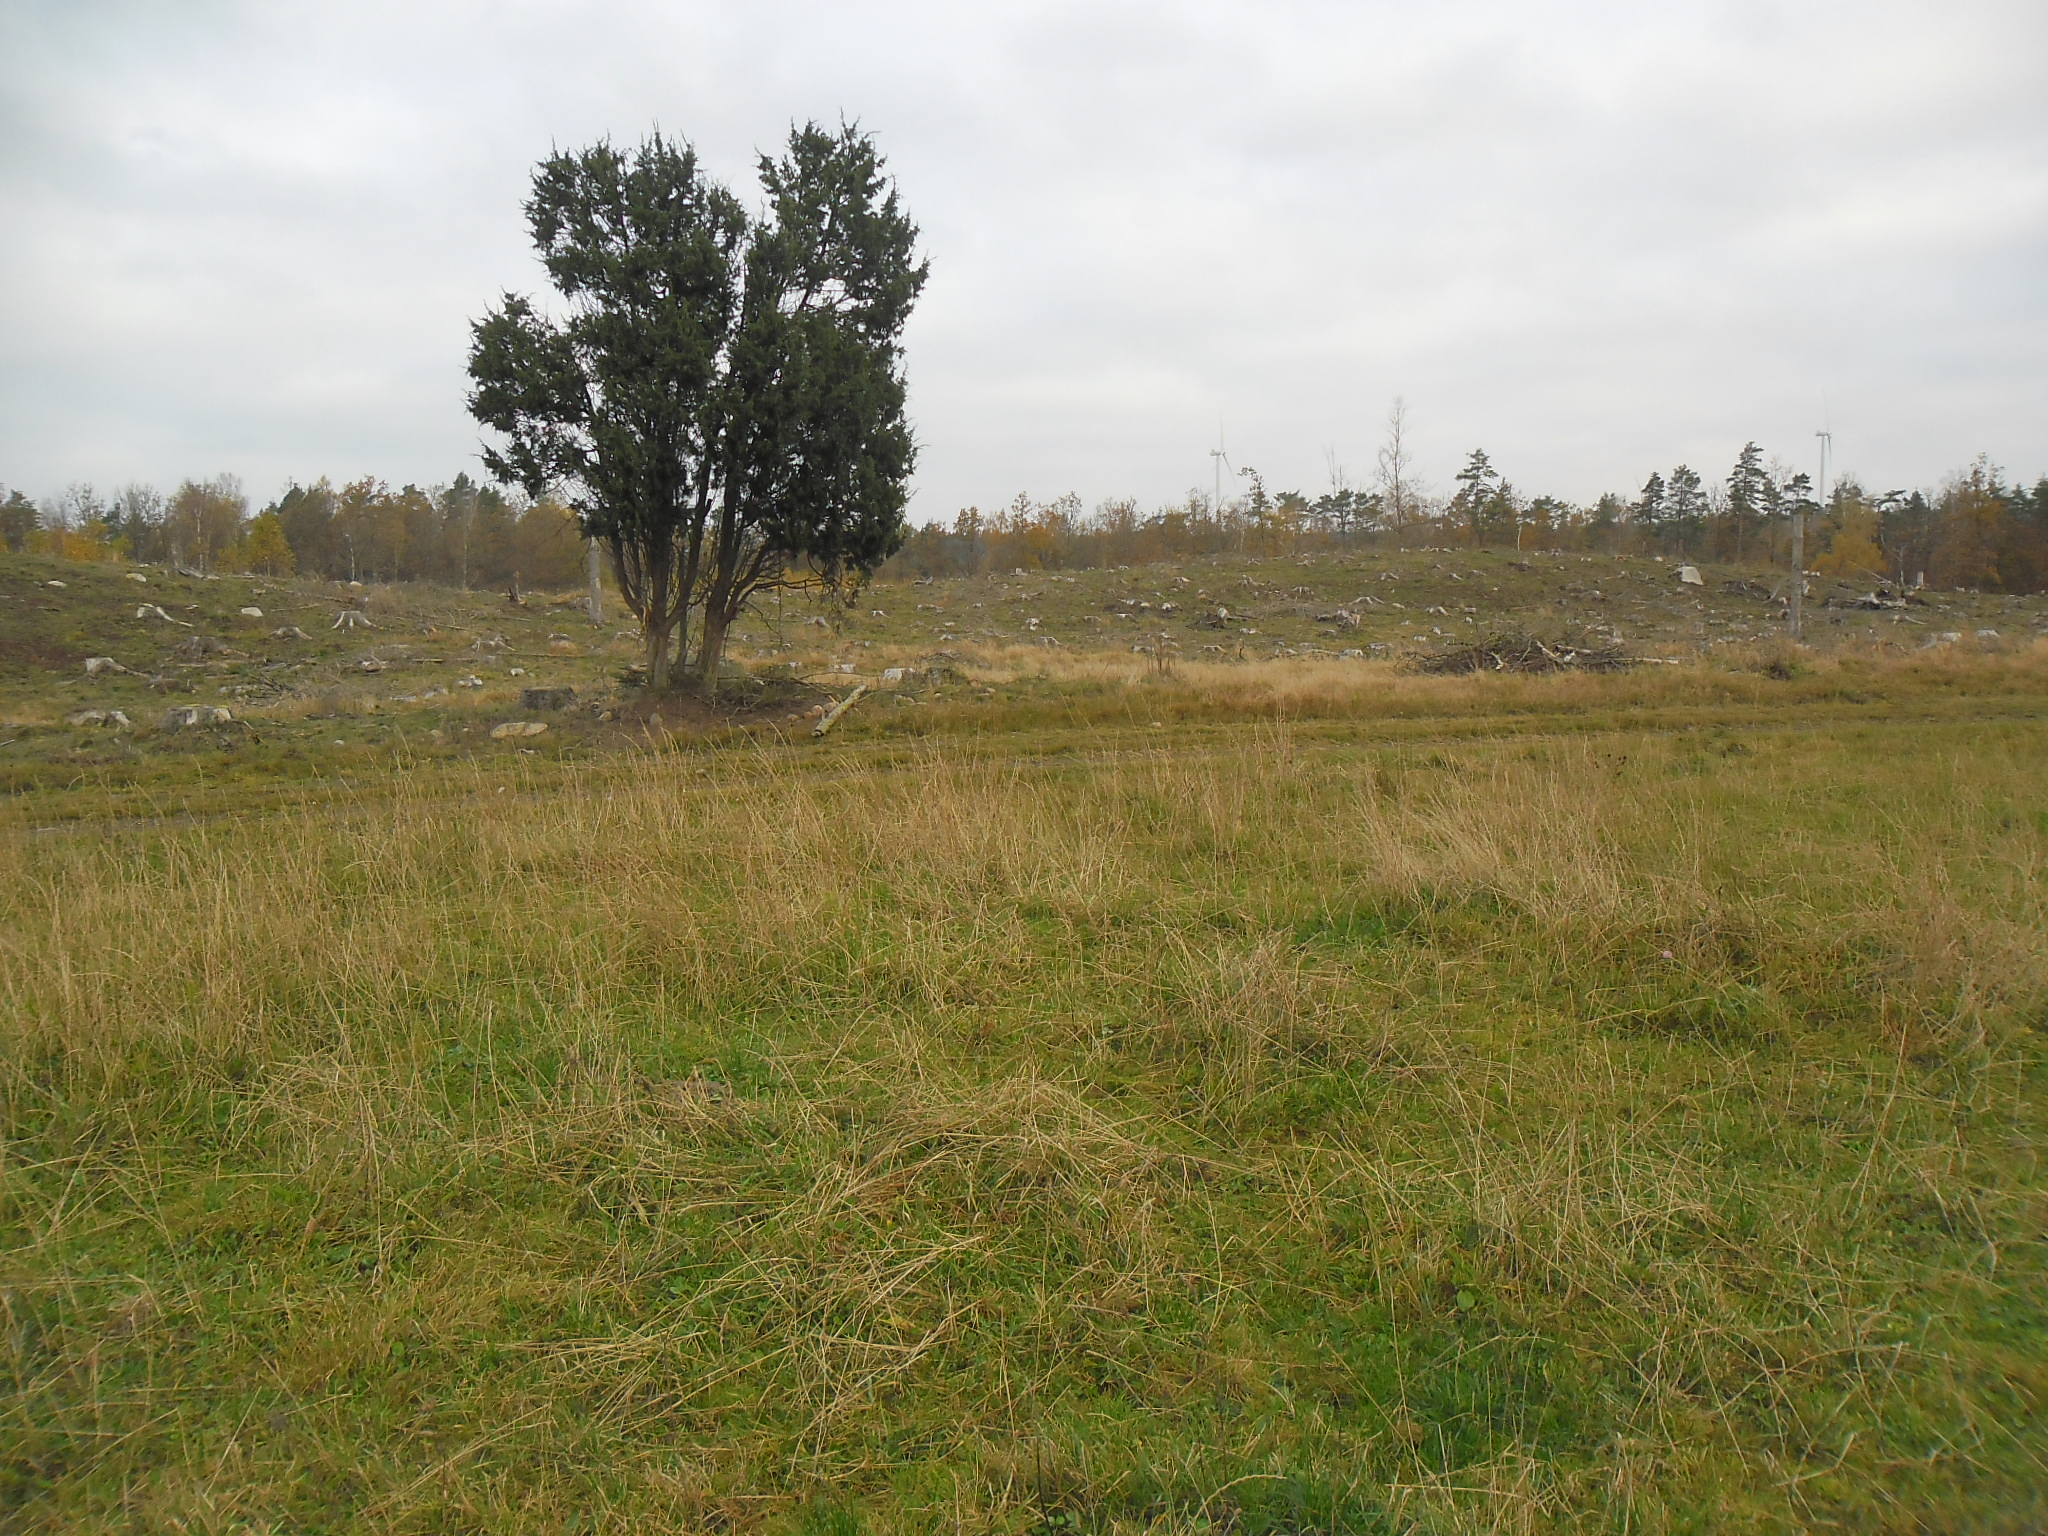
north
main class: Cropland
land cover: Temporary grasslands
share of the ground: > 75 %
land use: Agriculture (excluding fallow land and kitchen gardens)
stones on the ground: 25 - 50 %
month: October
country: SE
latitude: 56.5258
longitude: 13.1995
